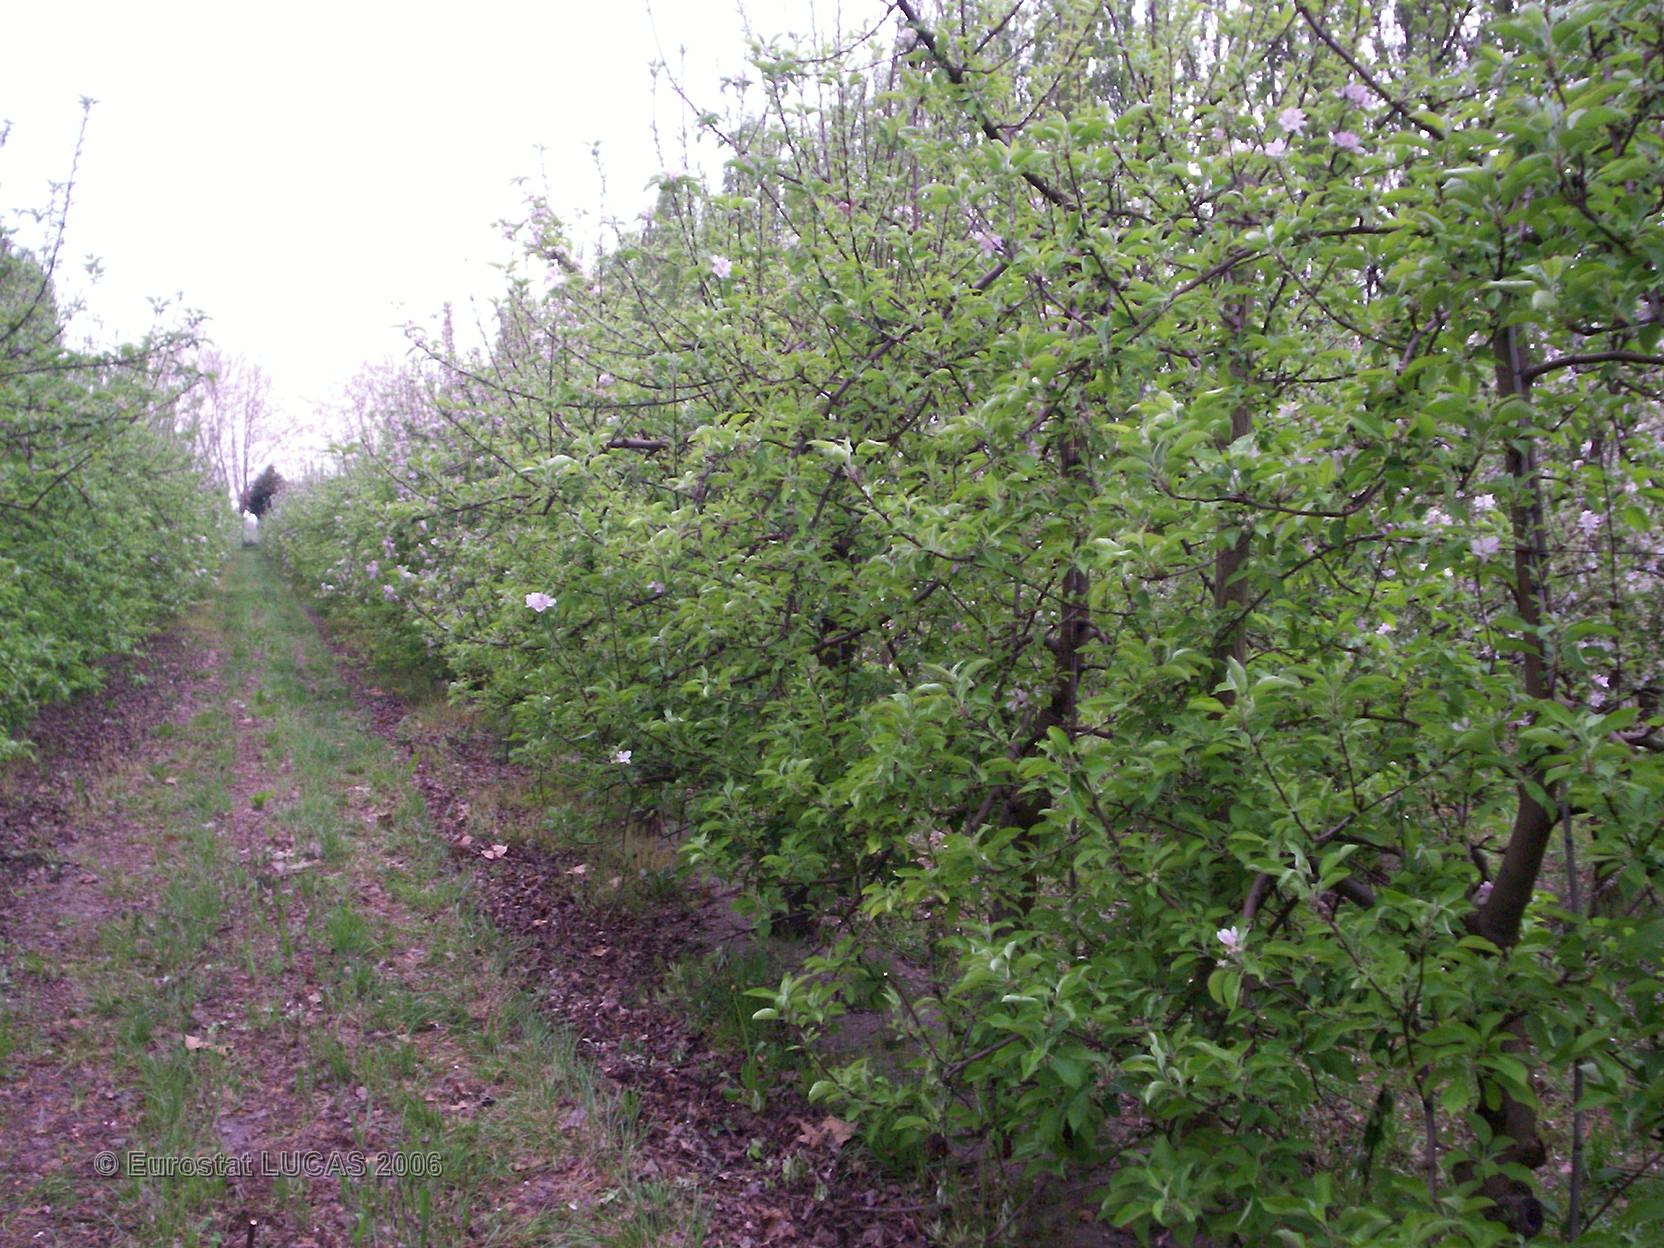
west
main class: Cropland
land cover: Apple fruit
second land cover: Grassland with sparse tree/shrub cover
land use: Agriculture (excluding fallow land and kitchen gardens)
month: April
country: FR
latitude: 43.8287
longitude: 4.9230
